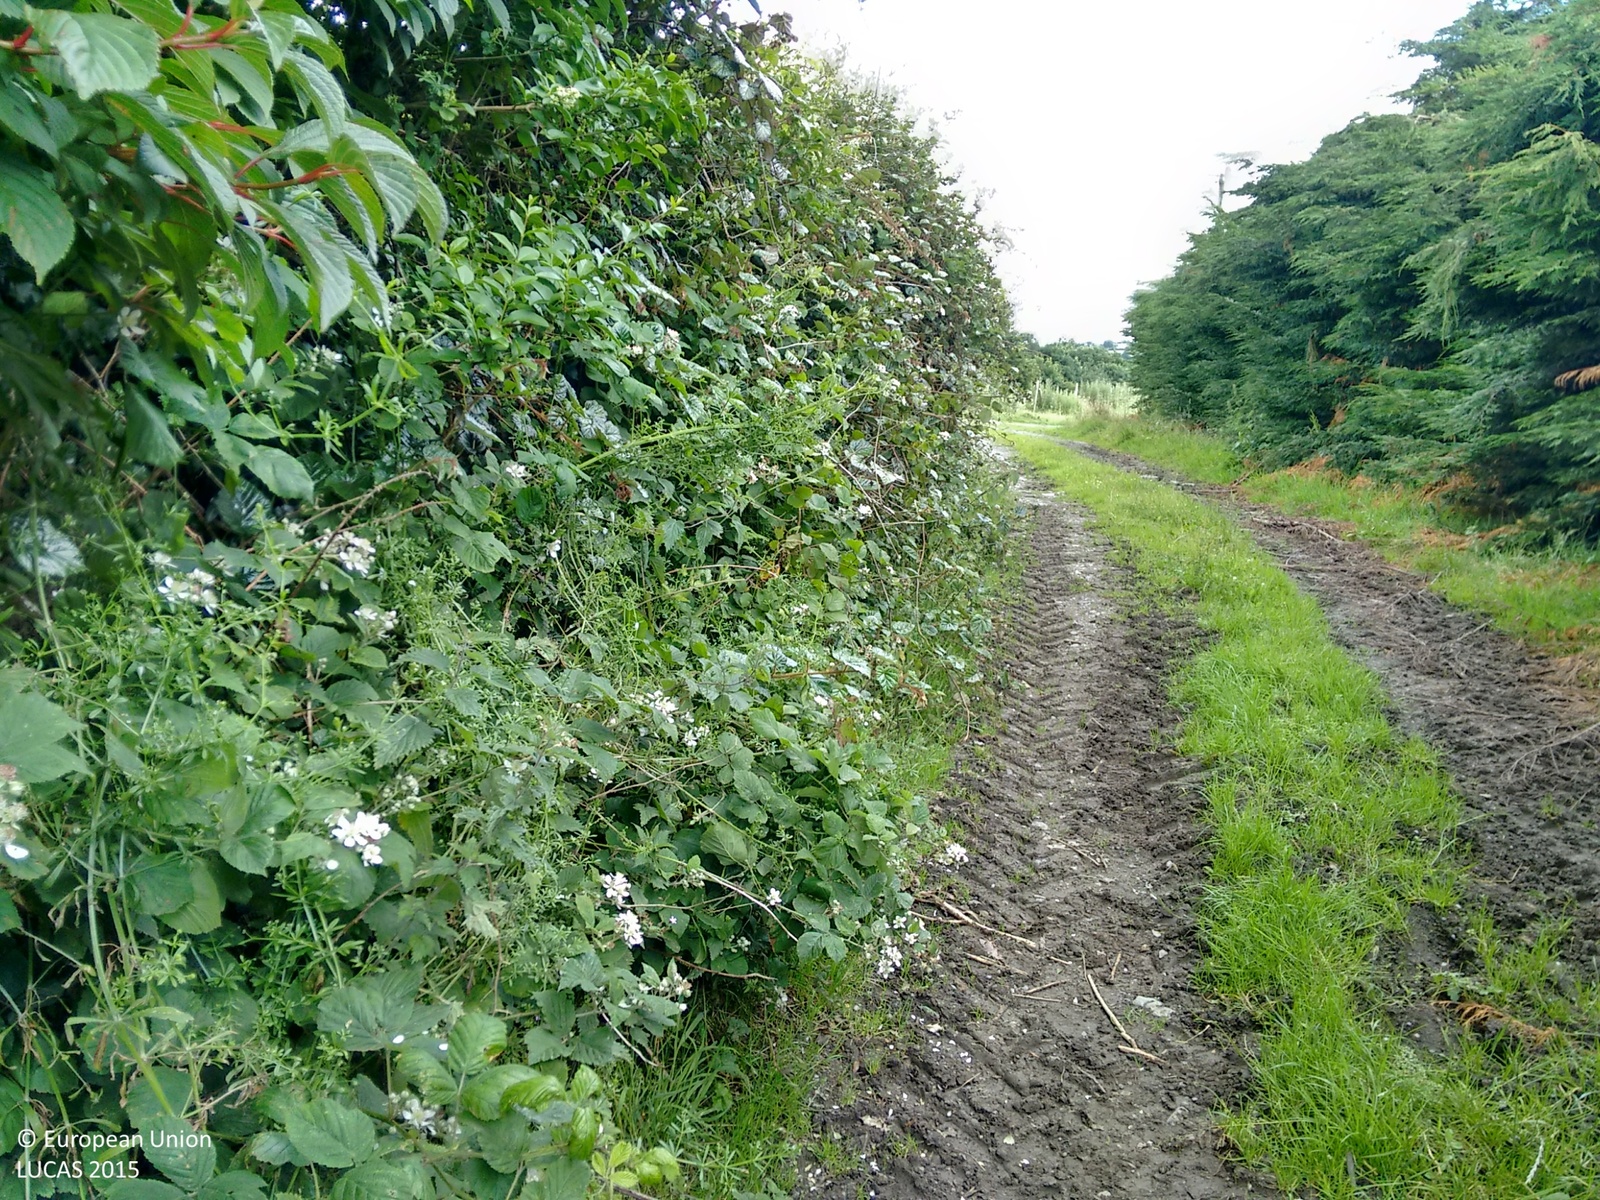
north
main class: Grassland
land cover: Grassland without tree/shrub cover
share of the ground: > 75 %
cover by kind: herbaceous plants 100 %
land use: Agriculture (excluding fallow land and kitchen gardens)
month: July
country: IE
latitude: 52.5999
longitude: -7.5683
